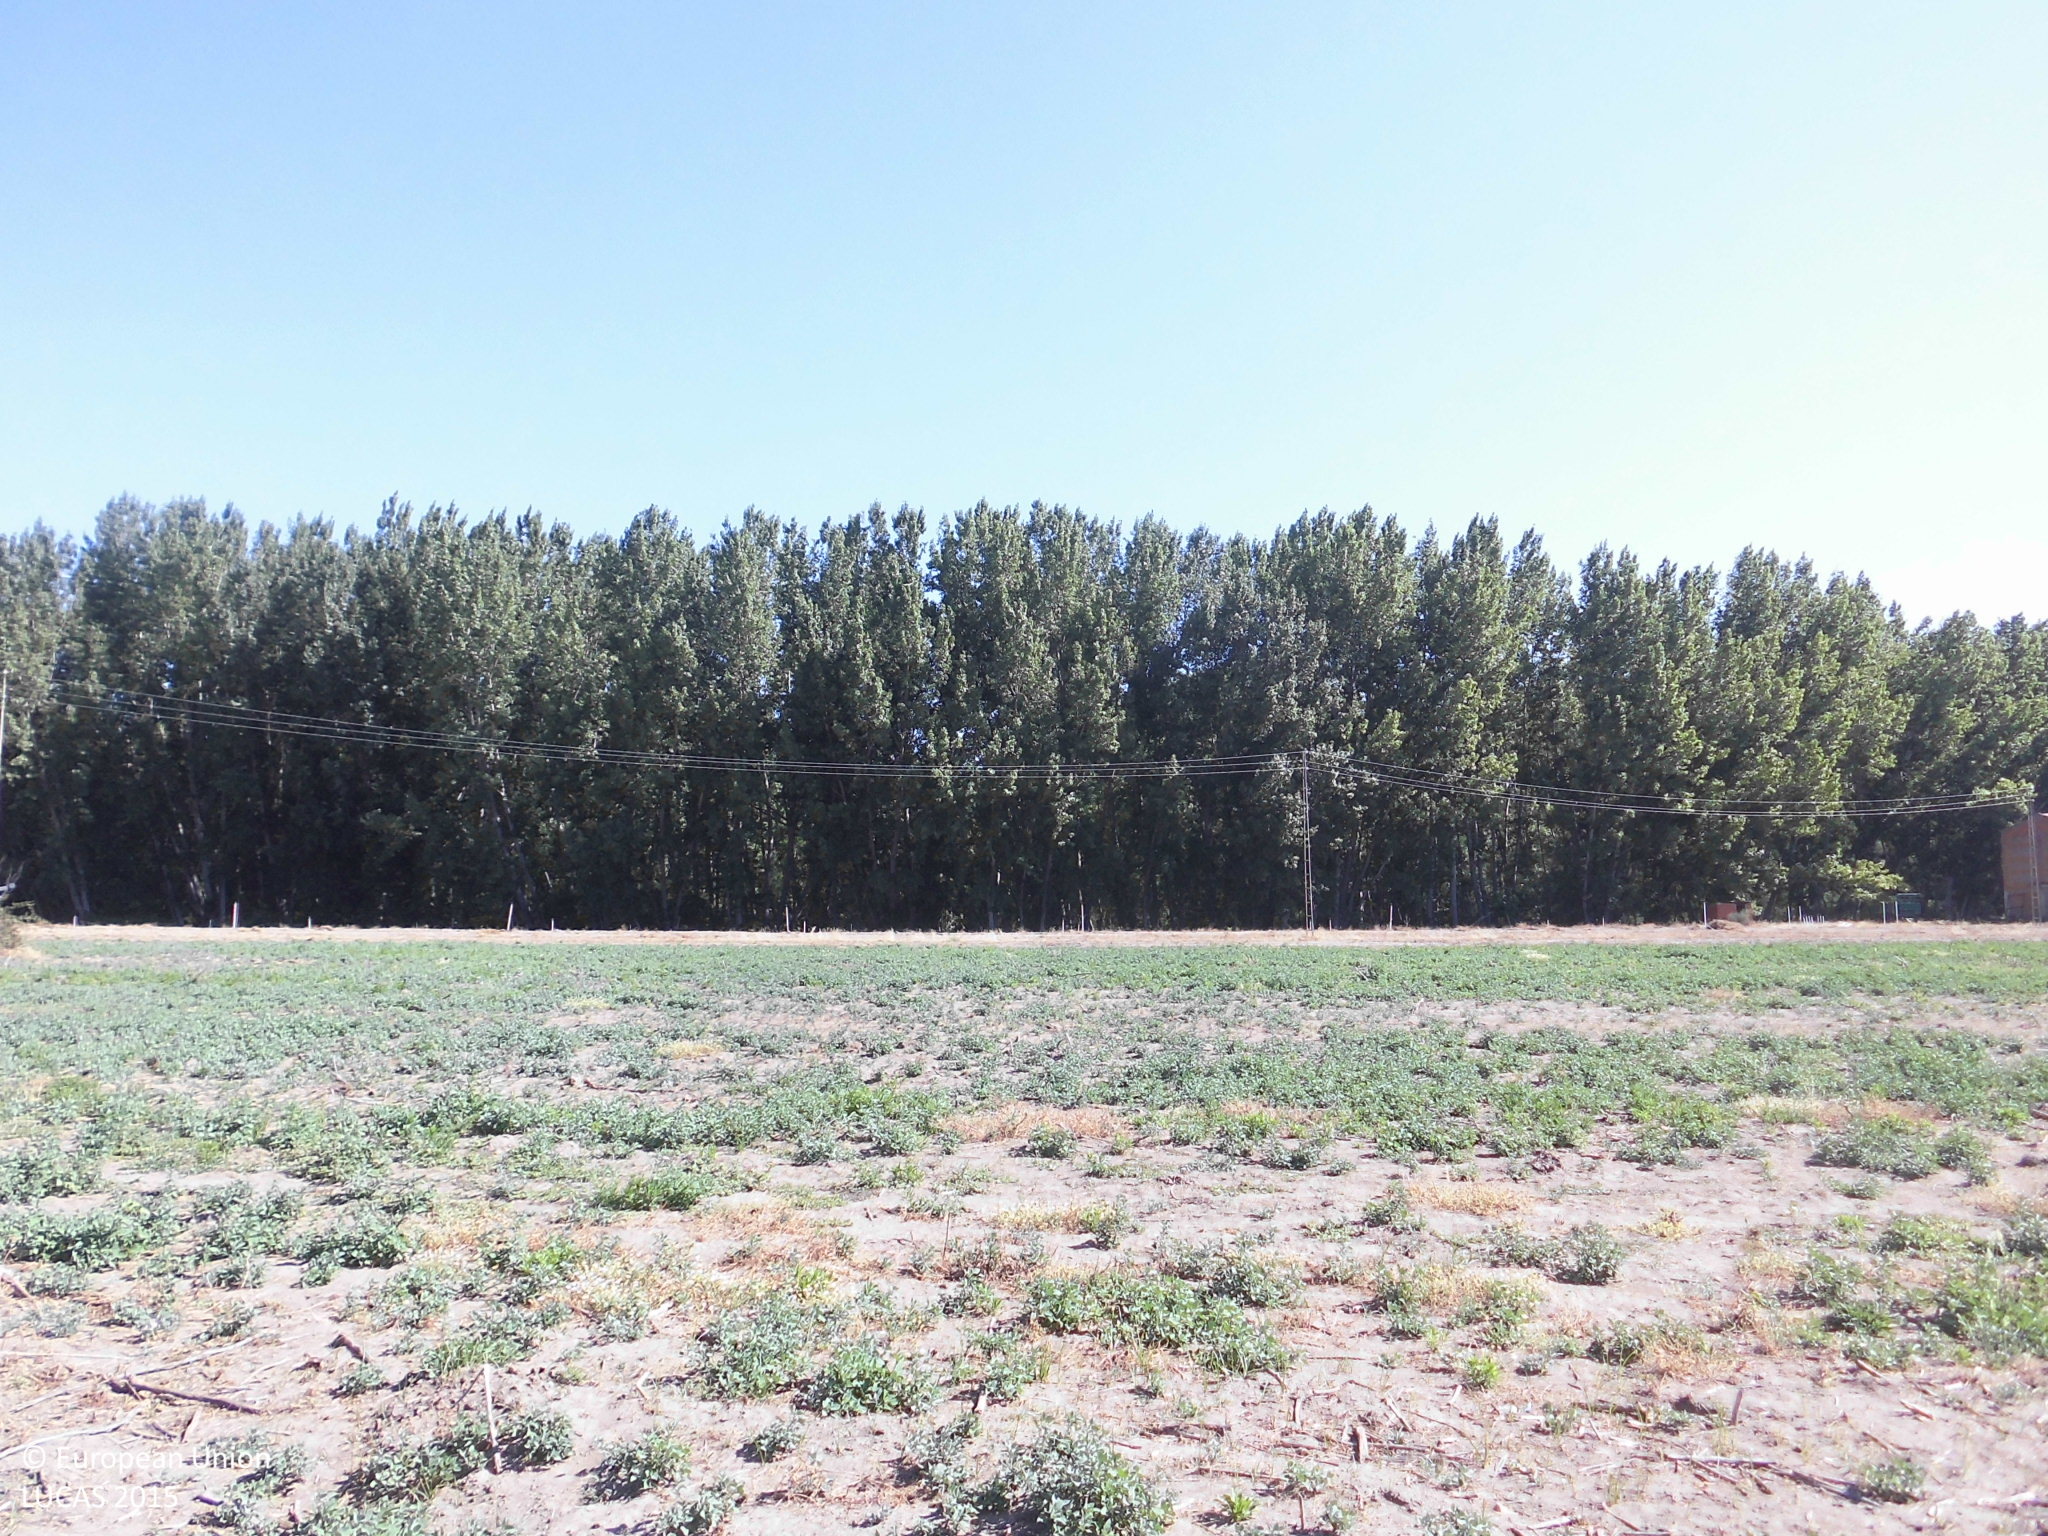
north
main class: Grassland
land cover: Spontaneously vegetated surfaces
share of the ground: > 75 %
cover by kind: herbaceous plants 90 %, unconsolidated bare surface 10 %
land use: Fallow land
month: July
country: ES
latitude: 40.0611
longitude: -6.1463
